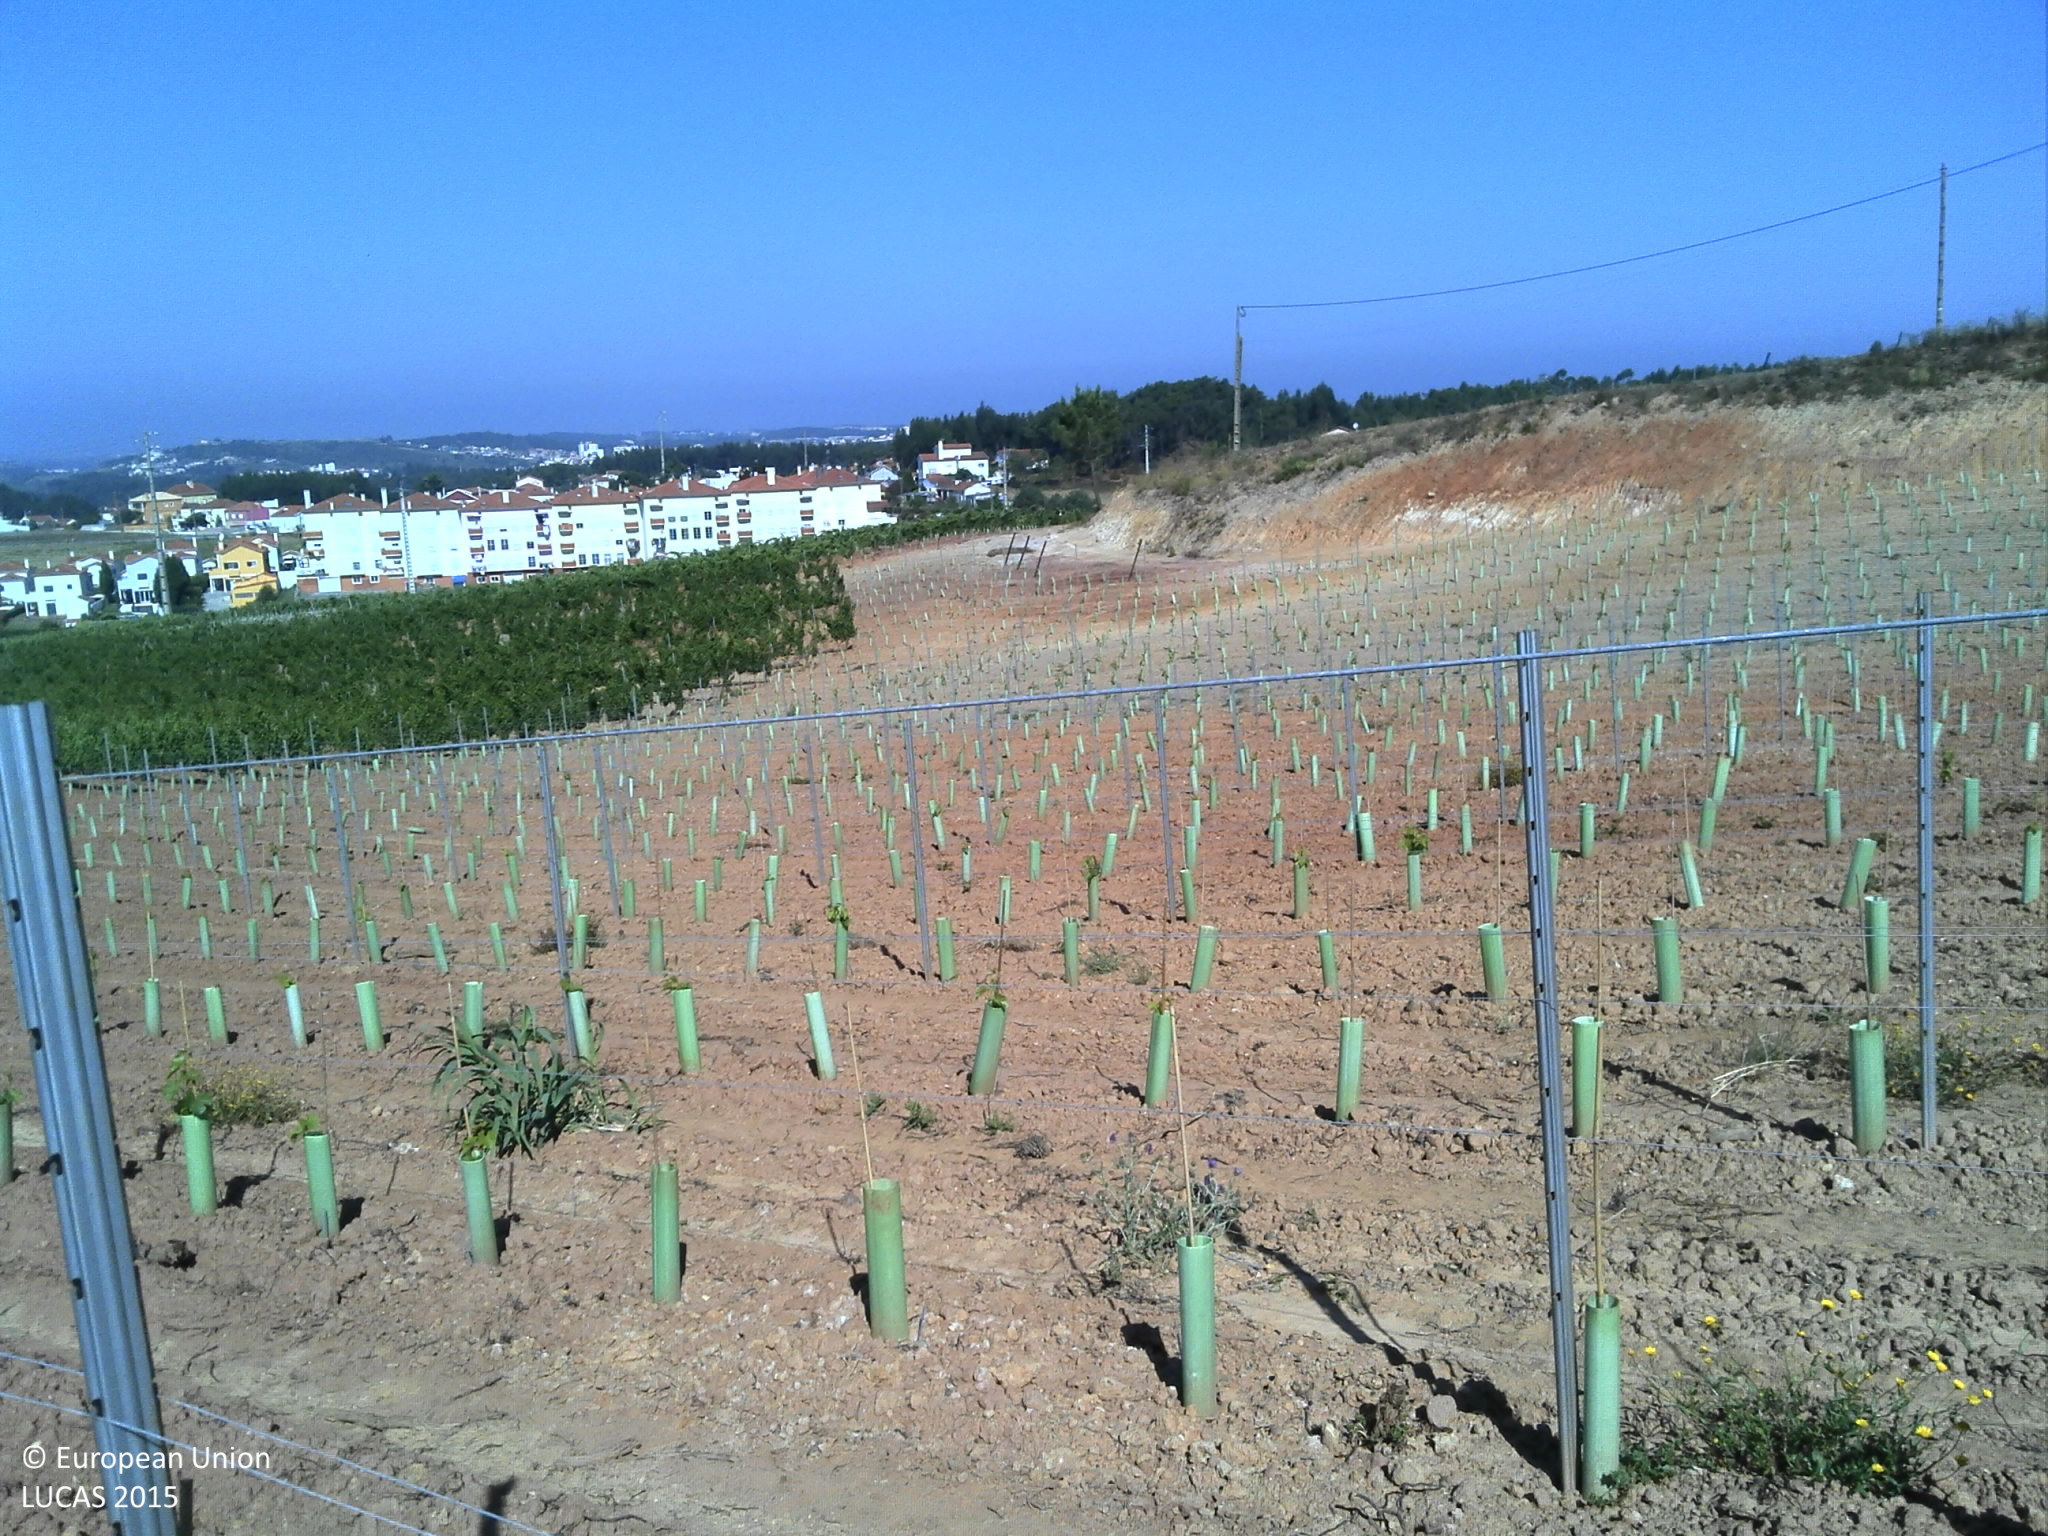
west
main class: Cropland
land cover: Vineyards
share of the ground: < 10 %
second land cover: Other bare soil
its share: > 75 %
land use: Agriculture (excluding fallow land and kitchen gardens)
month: June
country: PT
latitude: 39.1059
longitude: -9.2238
